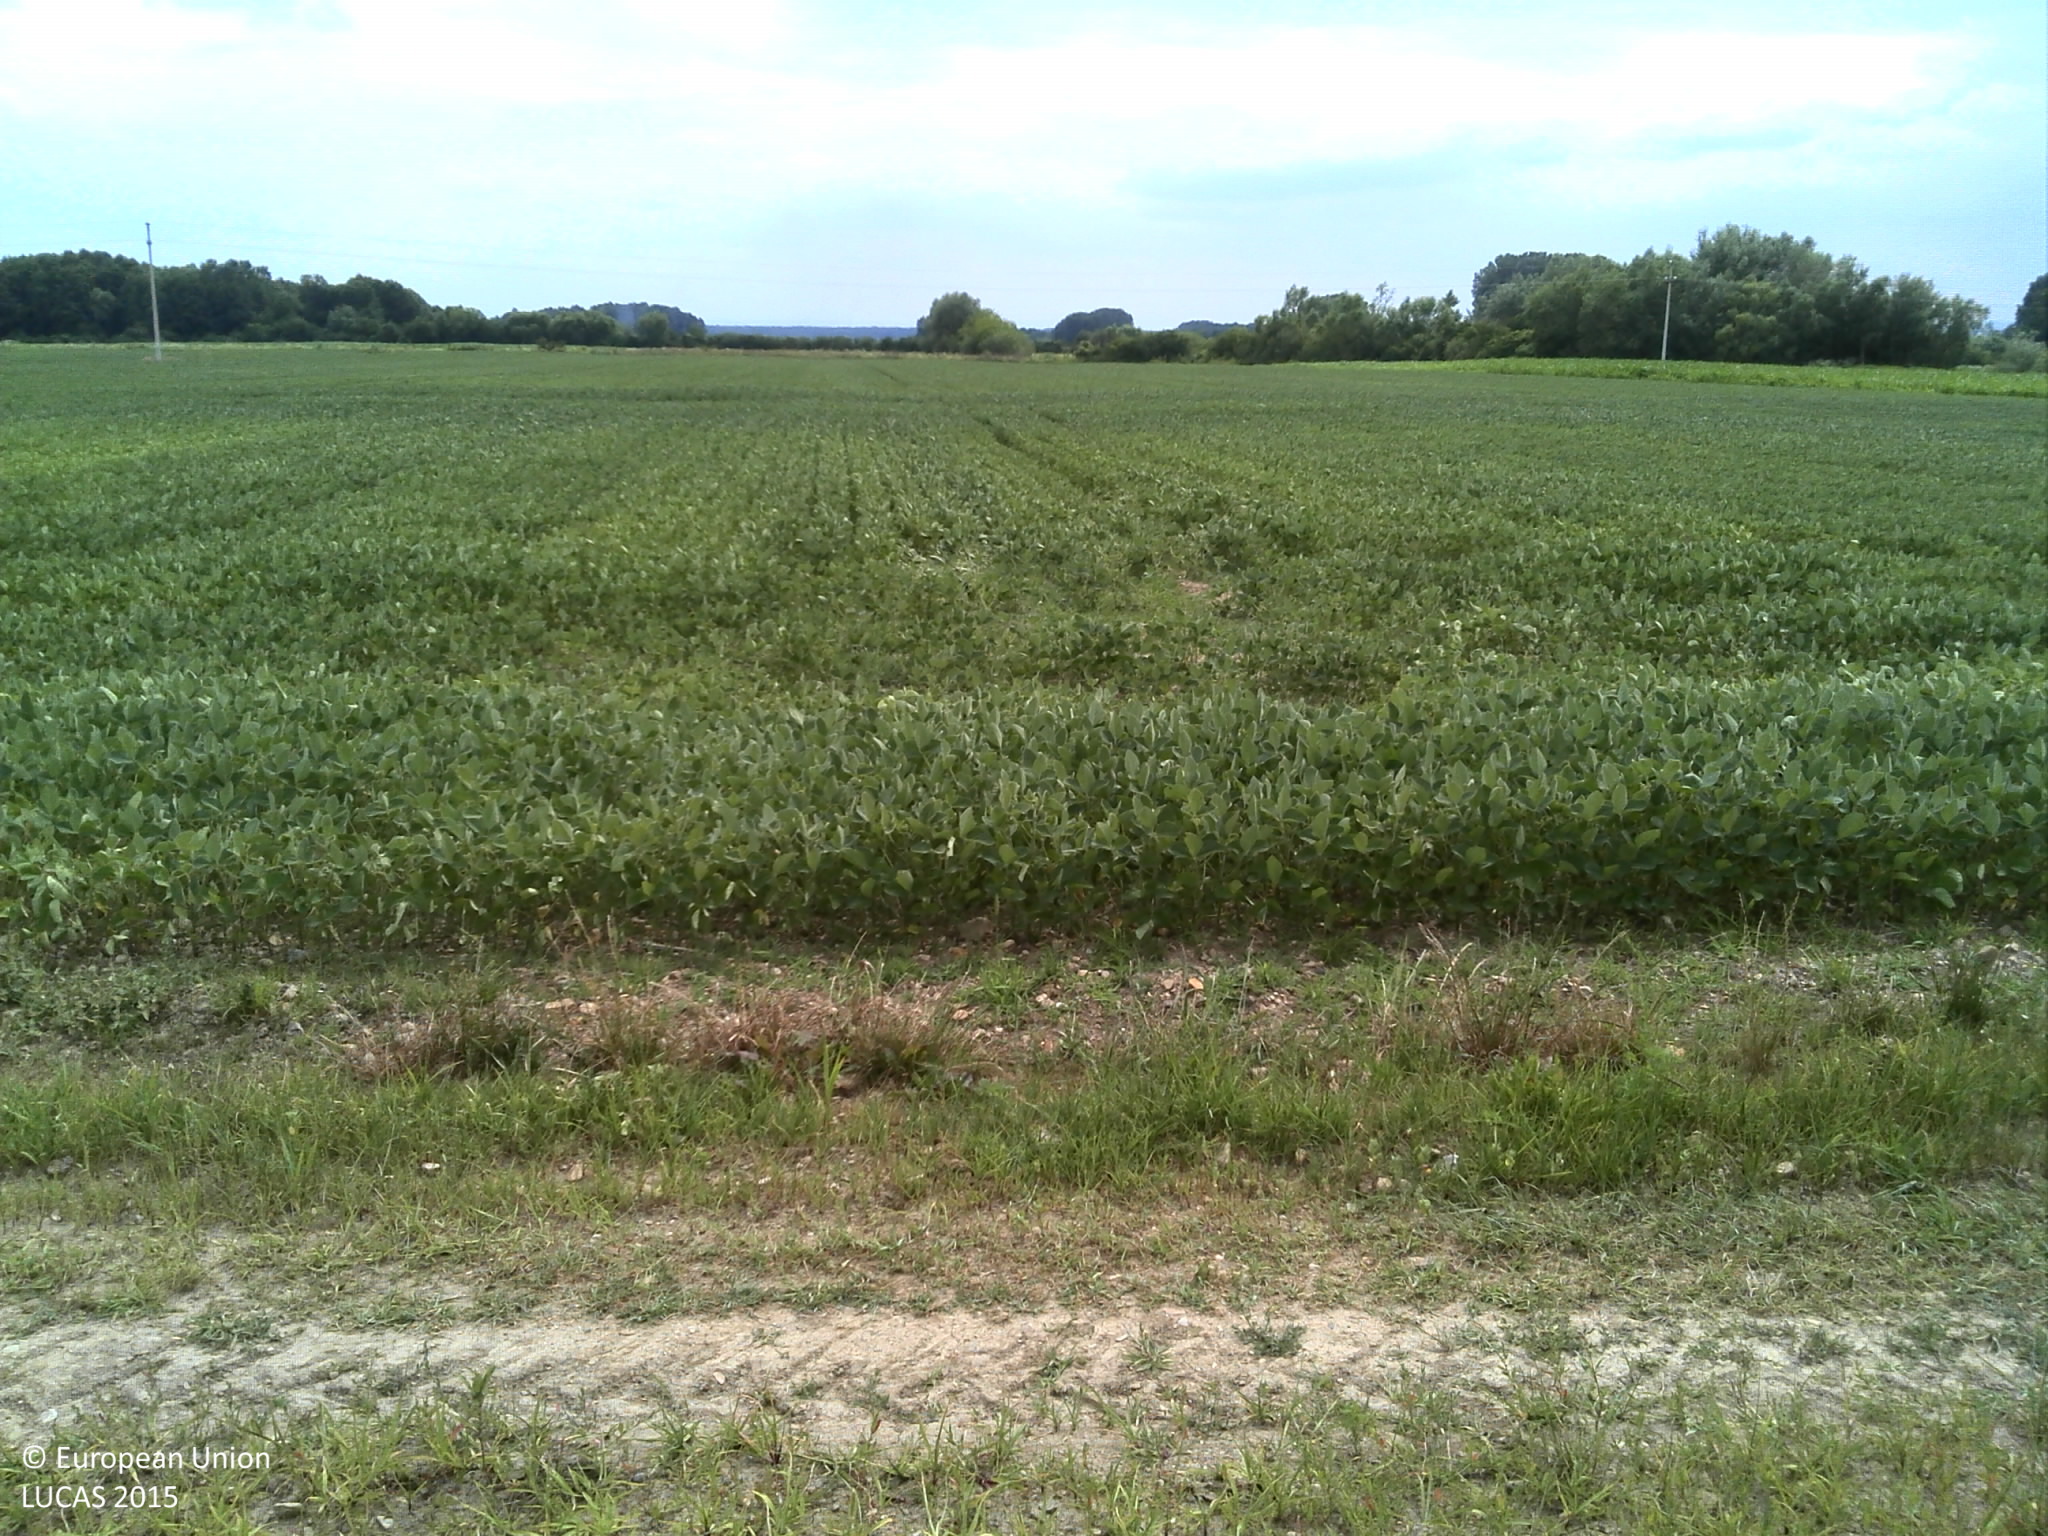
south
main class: Grassland
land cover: Spontaneously vegetated surfaces
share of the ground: > 75 %
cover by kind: herbaceous plants 95 %, lichens and mosses 5 %
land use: Semi-natural and natural areas not in use
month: June
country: HR
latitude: 45.2193
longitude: 17.5011
